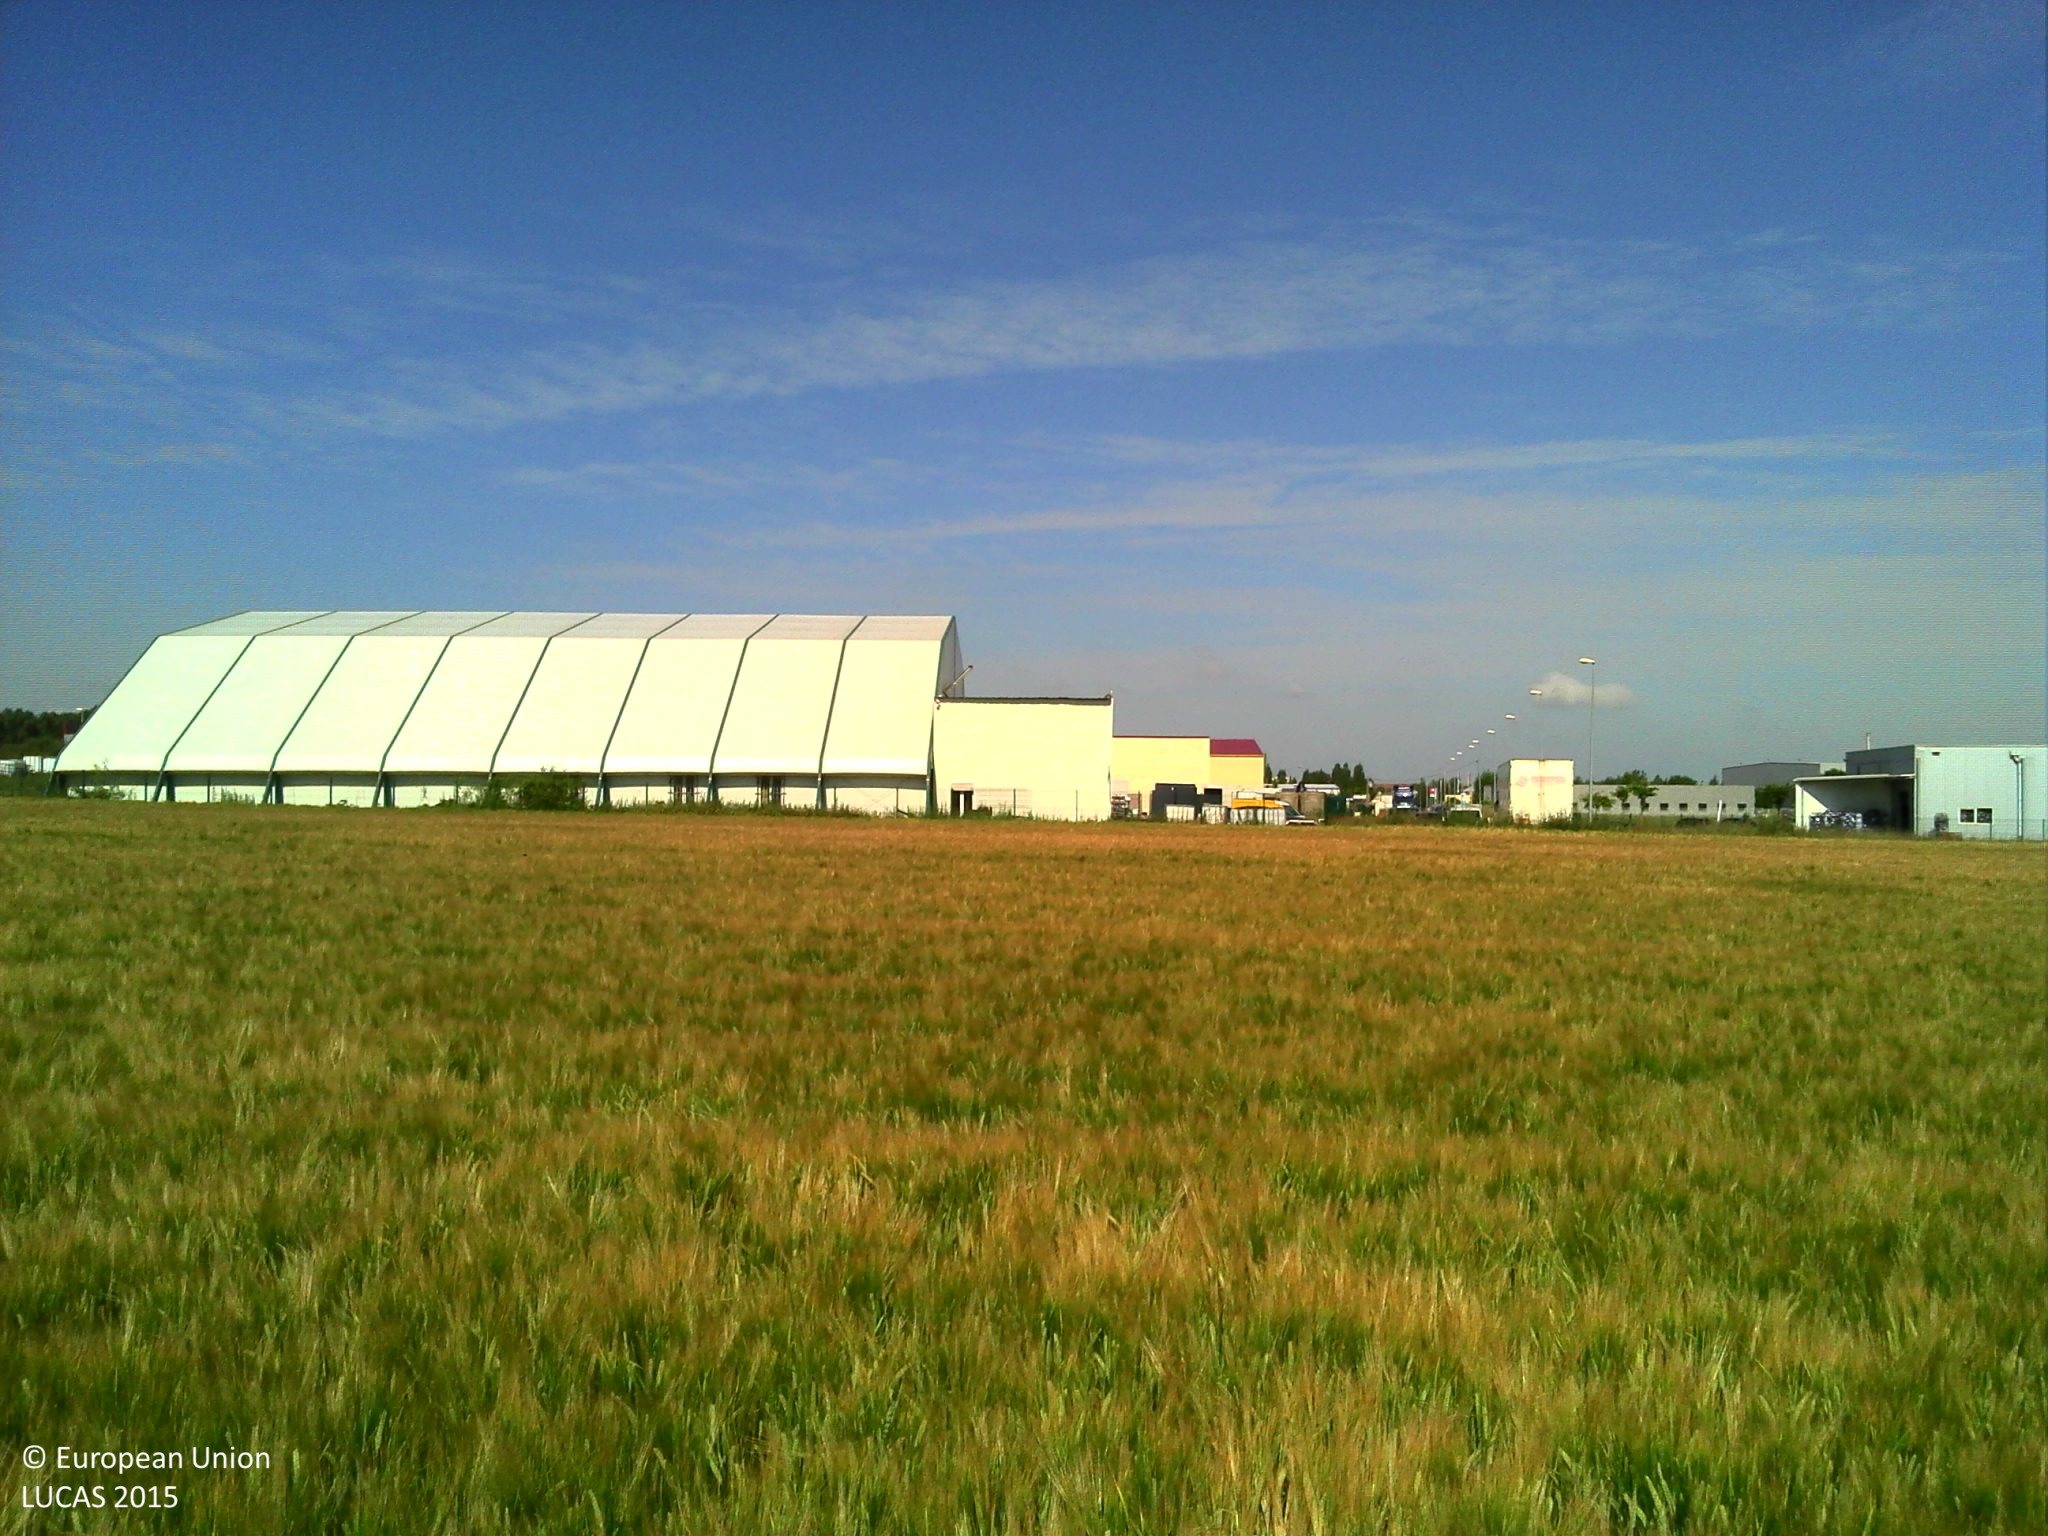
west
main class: Cropland
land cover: Barley
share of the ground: > 75 %
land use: Agriculture (excluding fallow land and kitchen gardens)
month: June
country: FR
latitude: 49.2238
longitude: 2.9192
